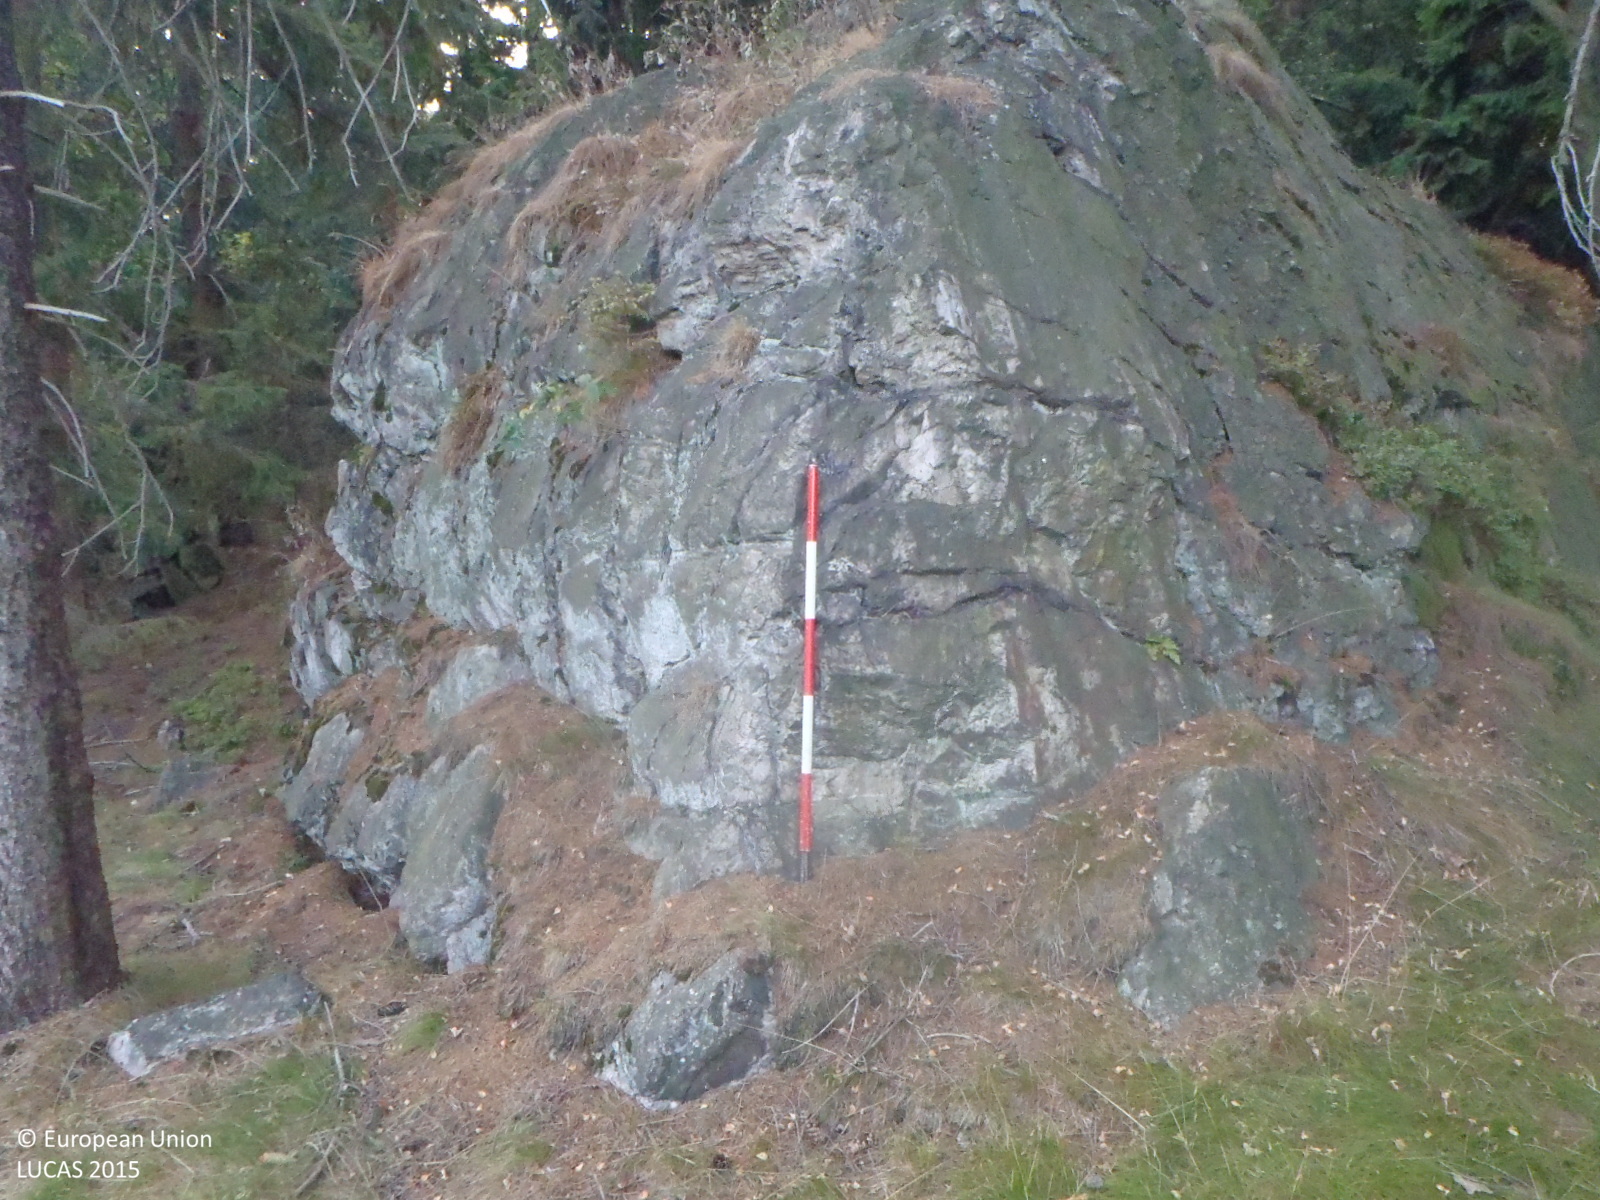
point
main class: Woodland
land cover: Spruce dominated coniferous woodland
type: hemiboreal forest and nemoral coniferous forest and mixed broadleaved-coniferous forest
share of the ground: > 75 %
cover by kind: coniferous forest trees 85 %, broadleaved forest trees 5 %, herbaceous plants 5 %
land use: Forestry
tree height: > 5 m
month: August
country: CZ
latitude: 50.7242
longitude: 14.9750
